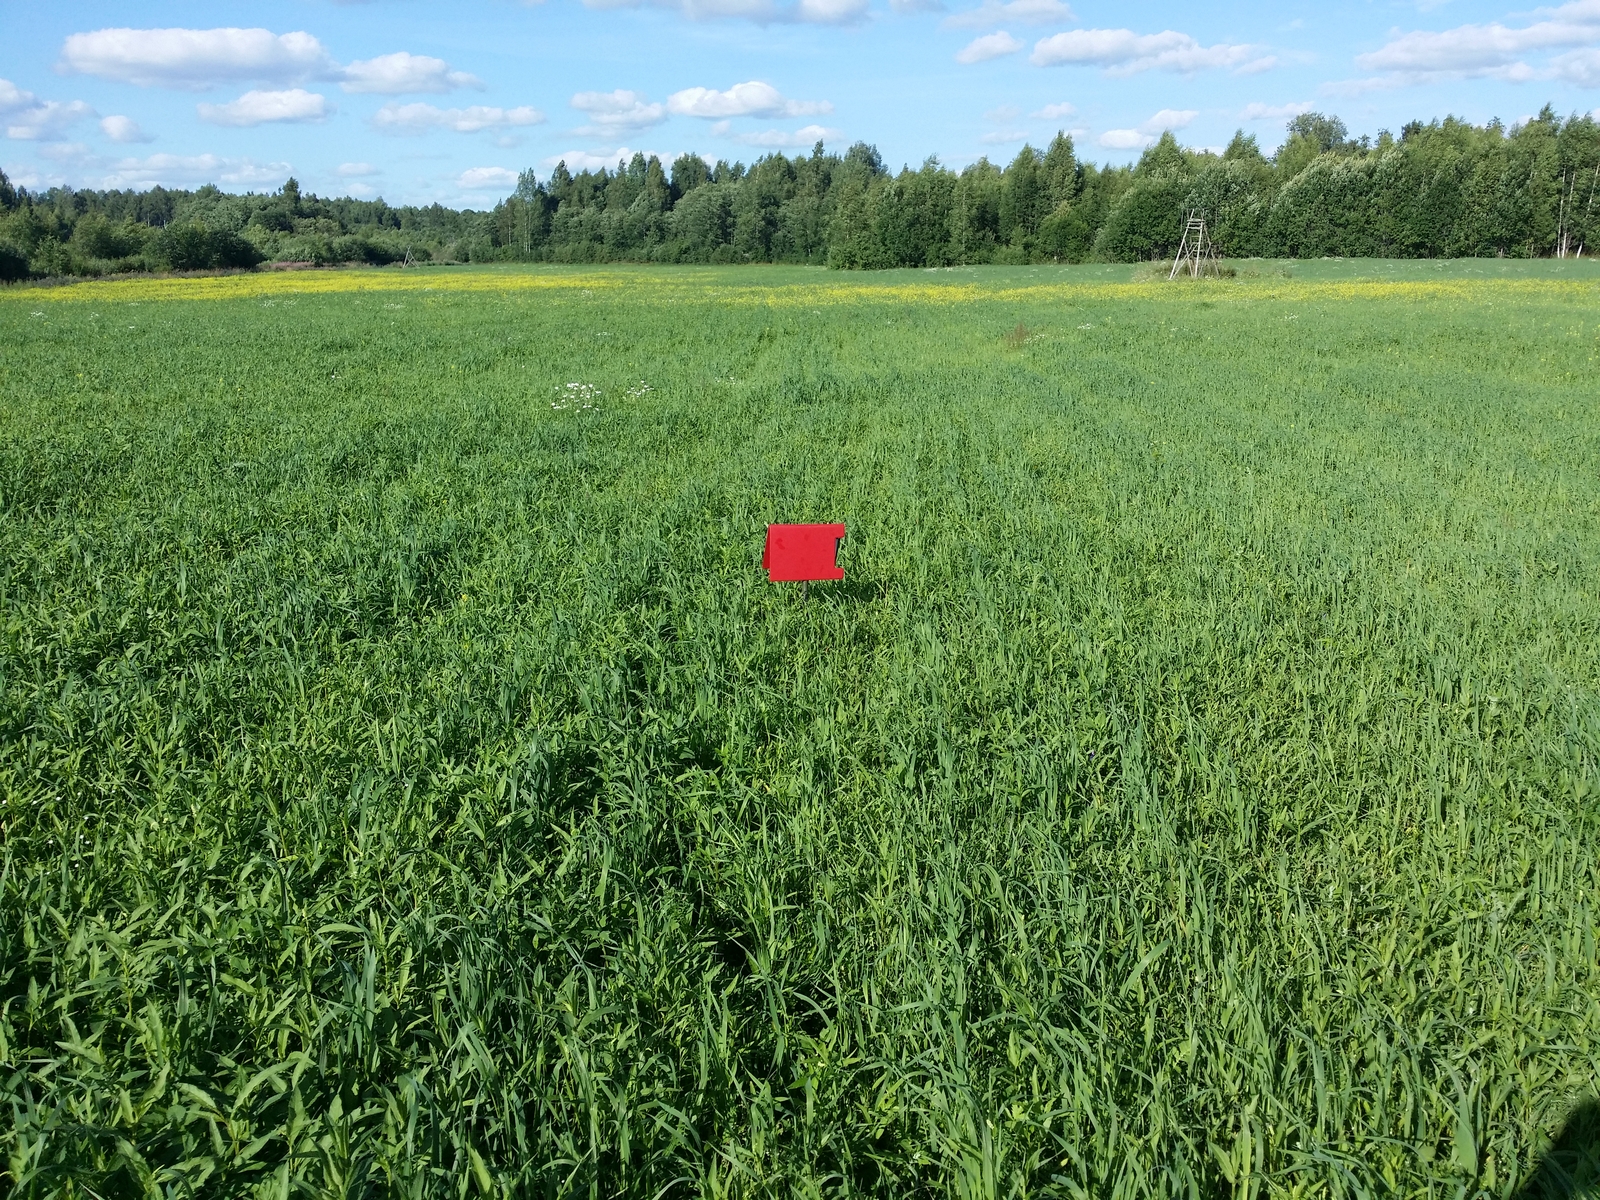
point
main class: Grassland
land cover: Grassland without tree/shrub cover
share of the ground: > 75 %
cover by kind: herbaceous plants 100 %
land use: Agriculture (excluding fallow land and kitchen gardens)
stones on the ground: < 10 %
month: July
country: LV
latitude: 57.2209
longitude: 27.2414
